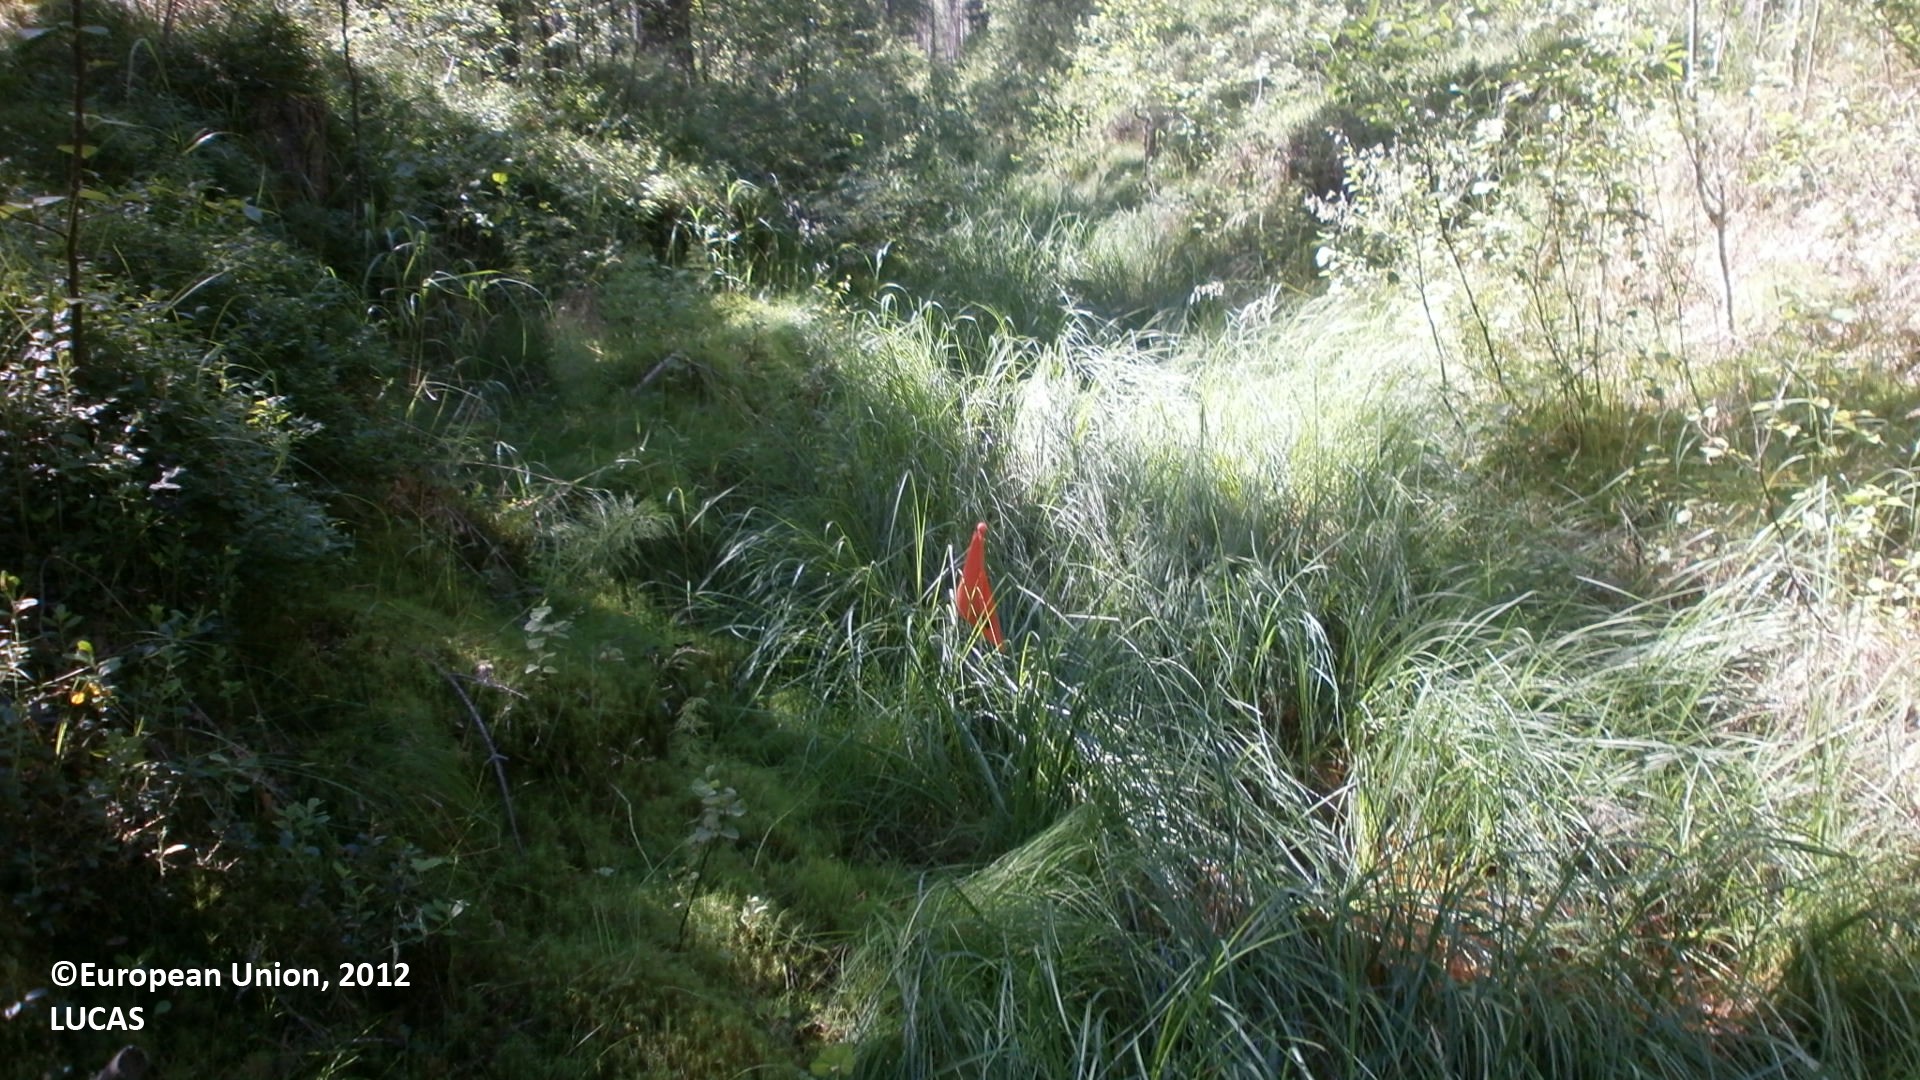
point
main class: Woodland
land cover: Pine dominated coniferous woodland
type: boreal forest
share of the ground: > 75 %
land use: Forestry
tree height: > 5 m
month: July
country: FI
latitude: 64.2950
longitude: 24.1368
